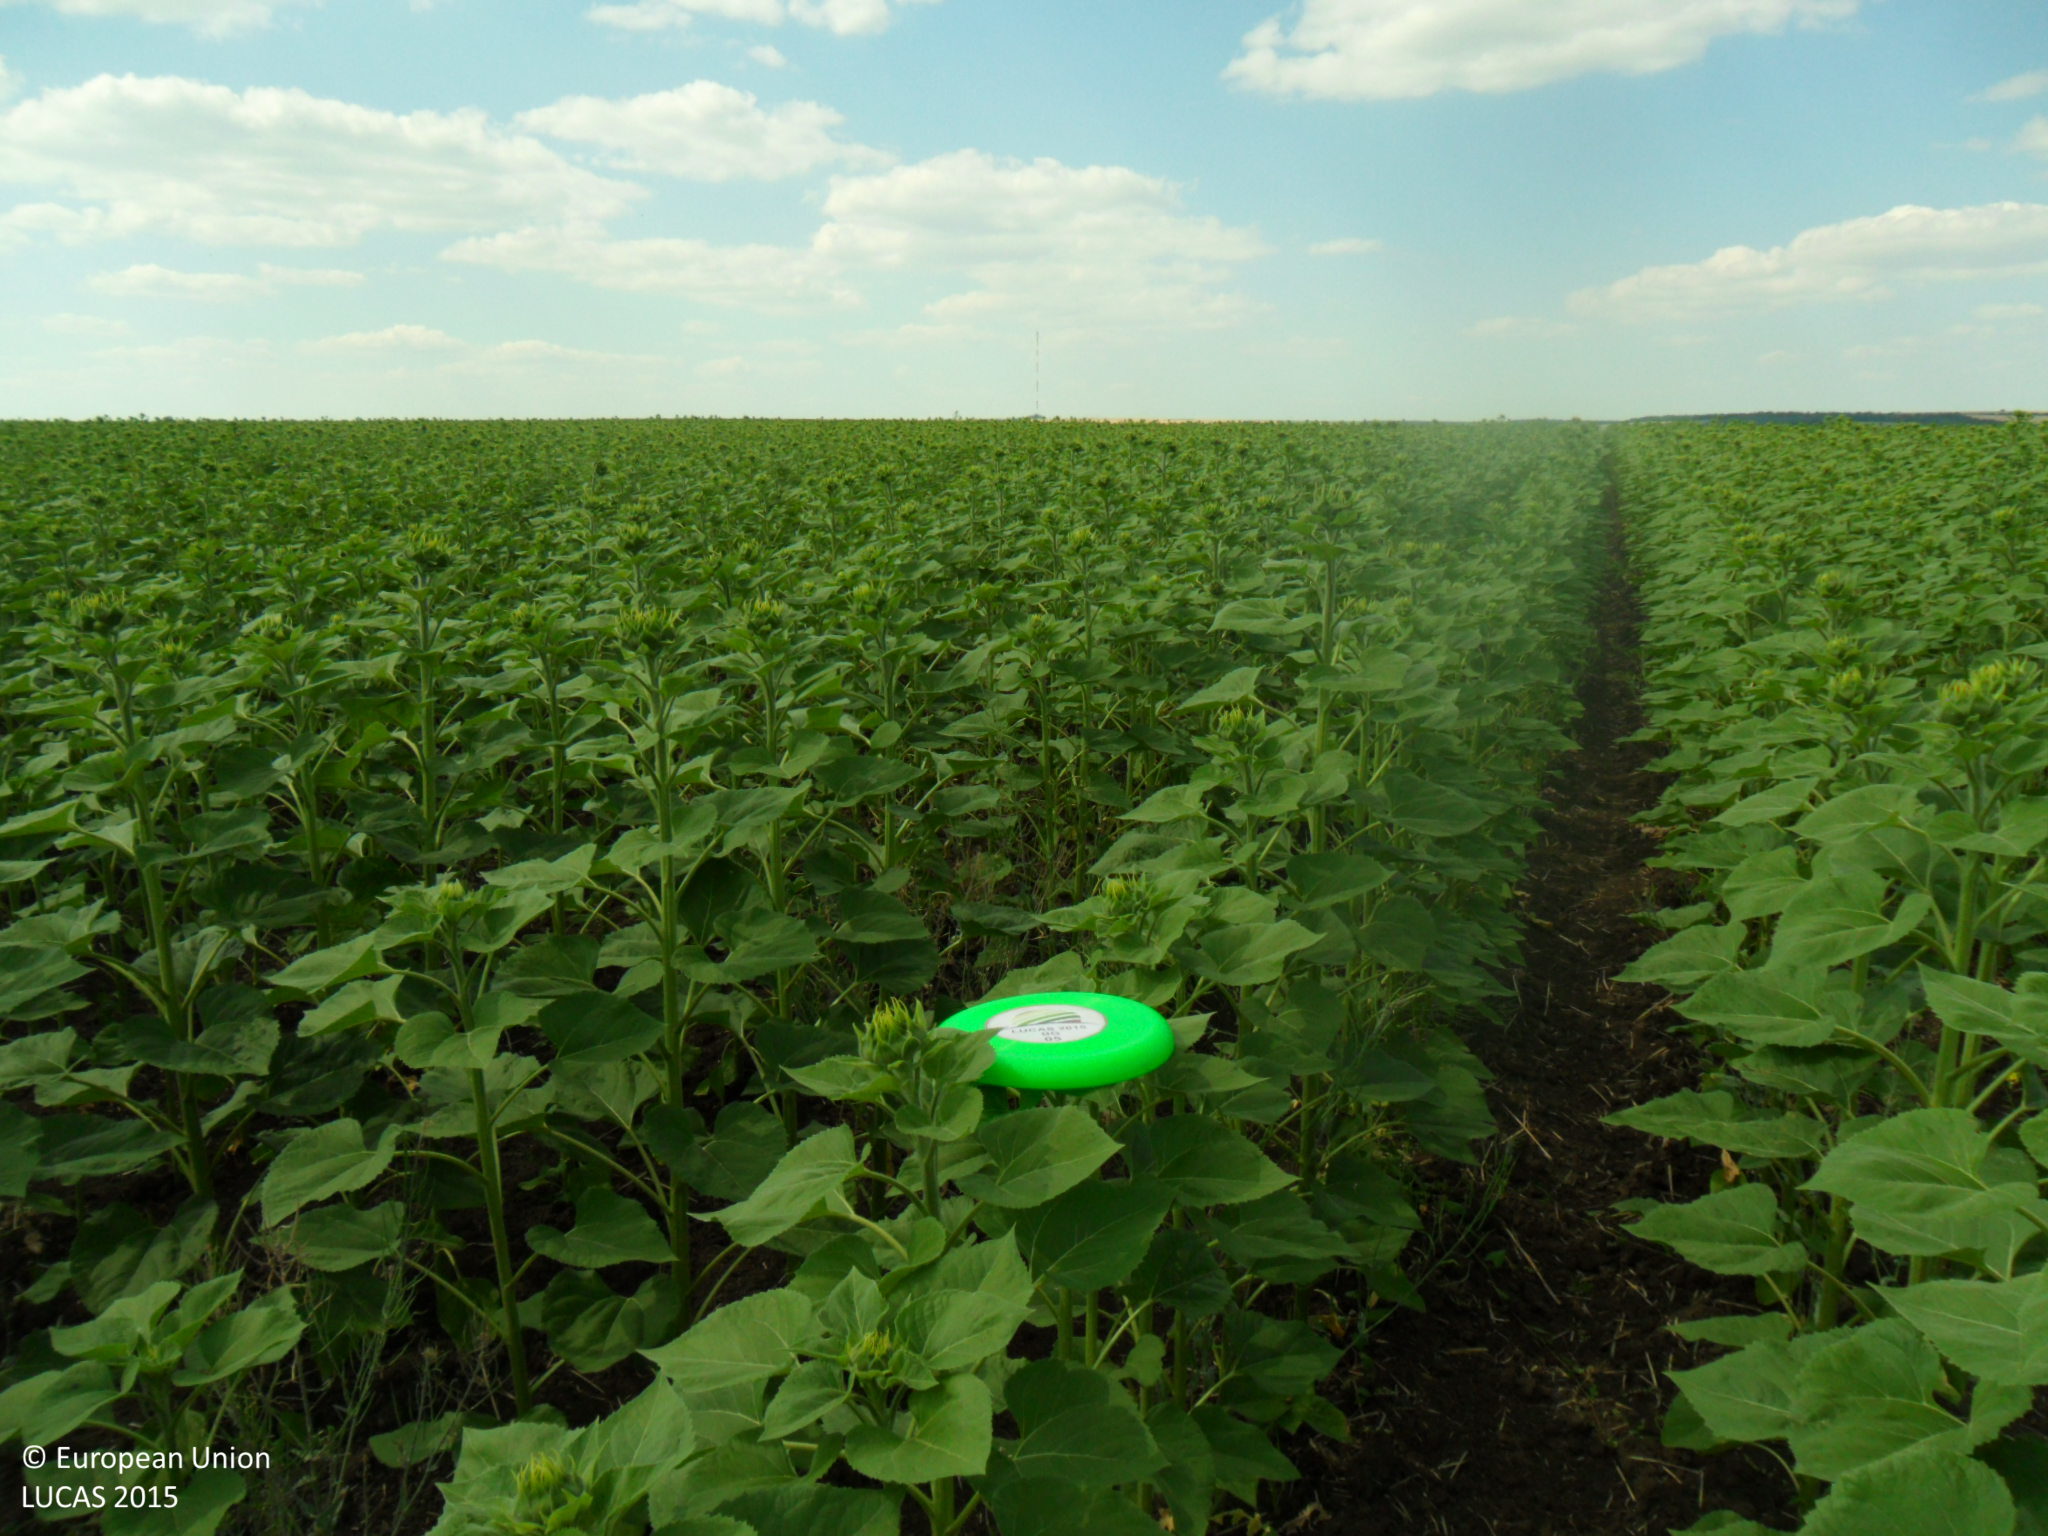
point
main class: Cropland
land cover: Sunflower
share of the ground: > 75 %
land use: Agriculture (excluding fallow land and kitchen gardens)
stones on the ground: < 10 %
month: June
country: BG
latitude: 43.4477
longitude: 26.9072
